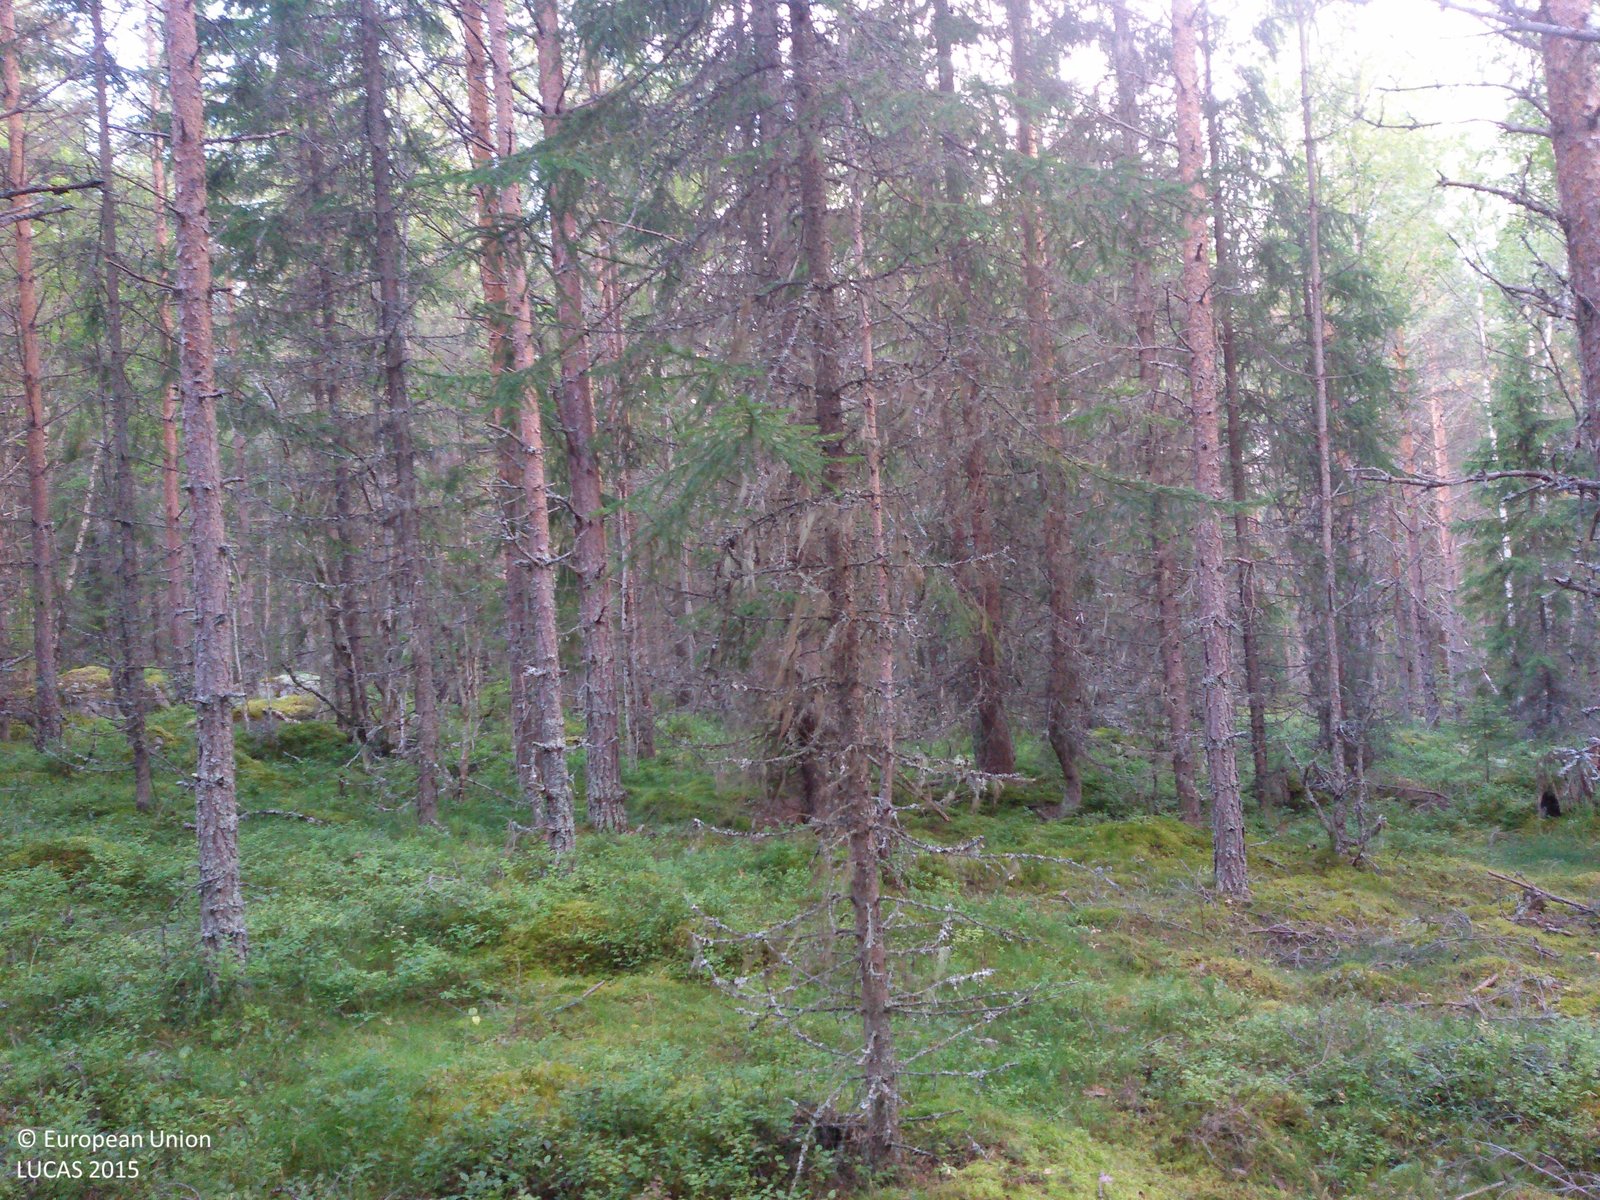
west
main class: Woodland
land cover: Pine dominated coniferous woodland
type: boreal forest
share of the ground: > 75 %
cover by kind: coniferous forest trees 80 %, shrubs 15 %, lichens and mosses 5 %
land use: Forestry
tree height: > 5 m
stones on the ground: 25 - 50 %
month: August
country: SE
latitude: 61.0181
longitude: 15.8137
